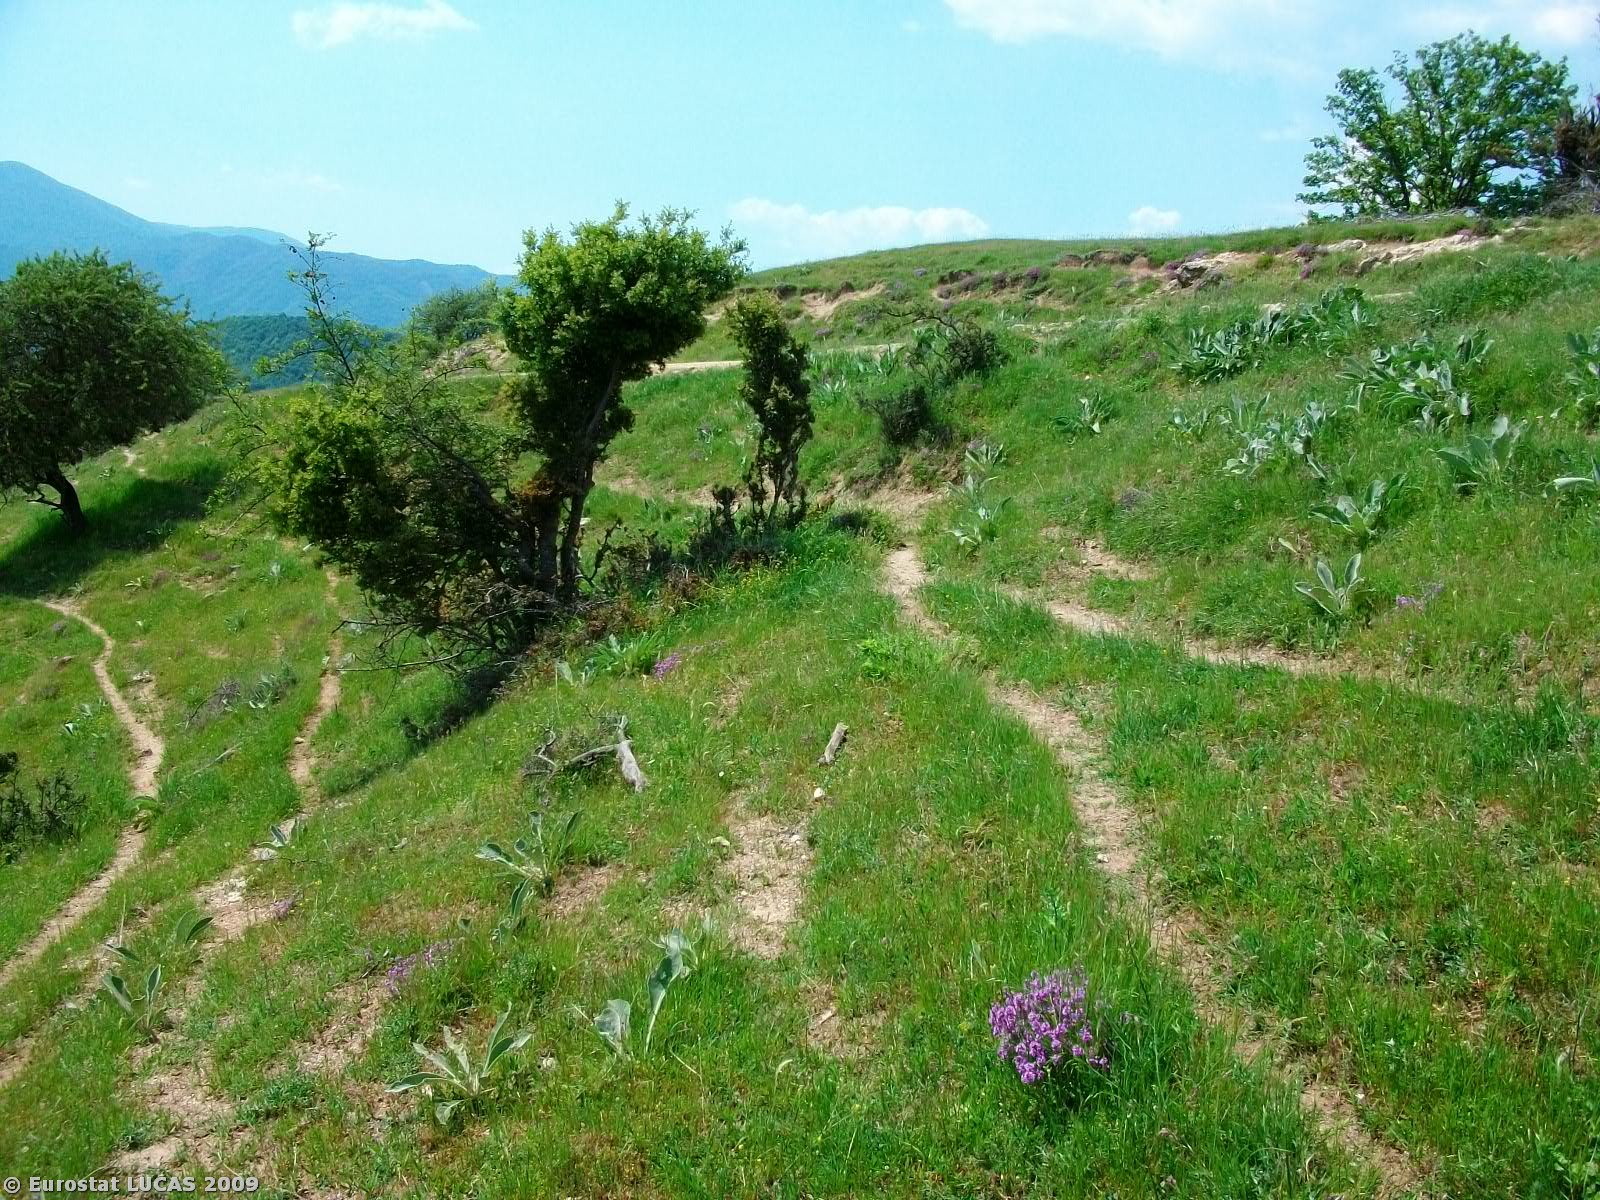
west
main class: Grassland
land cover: Grassland without tree/shrub cover
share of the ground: 50 - 75 %
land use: Agriculture (excluding fallow land and kitchen gardens)
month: May
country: GR
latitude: 41.2369
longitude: 24.6303
